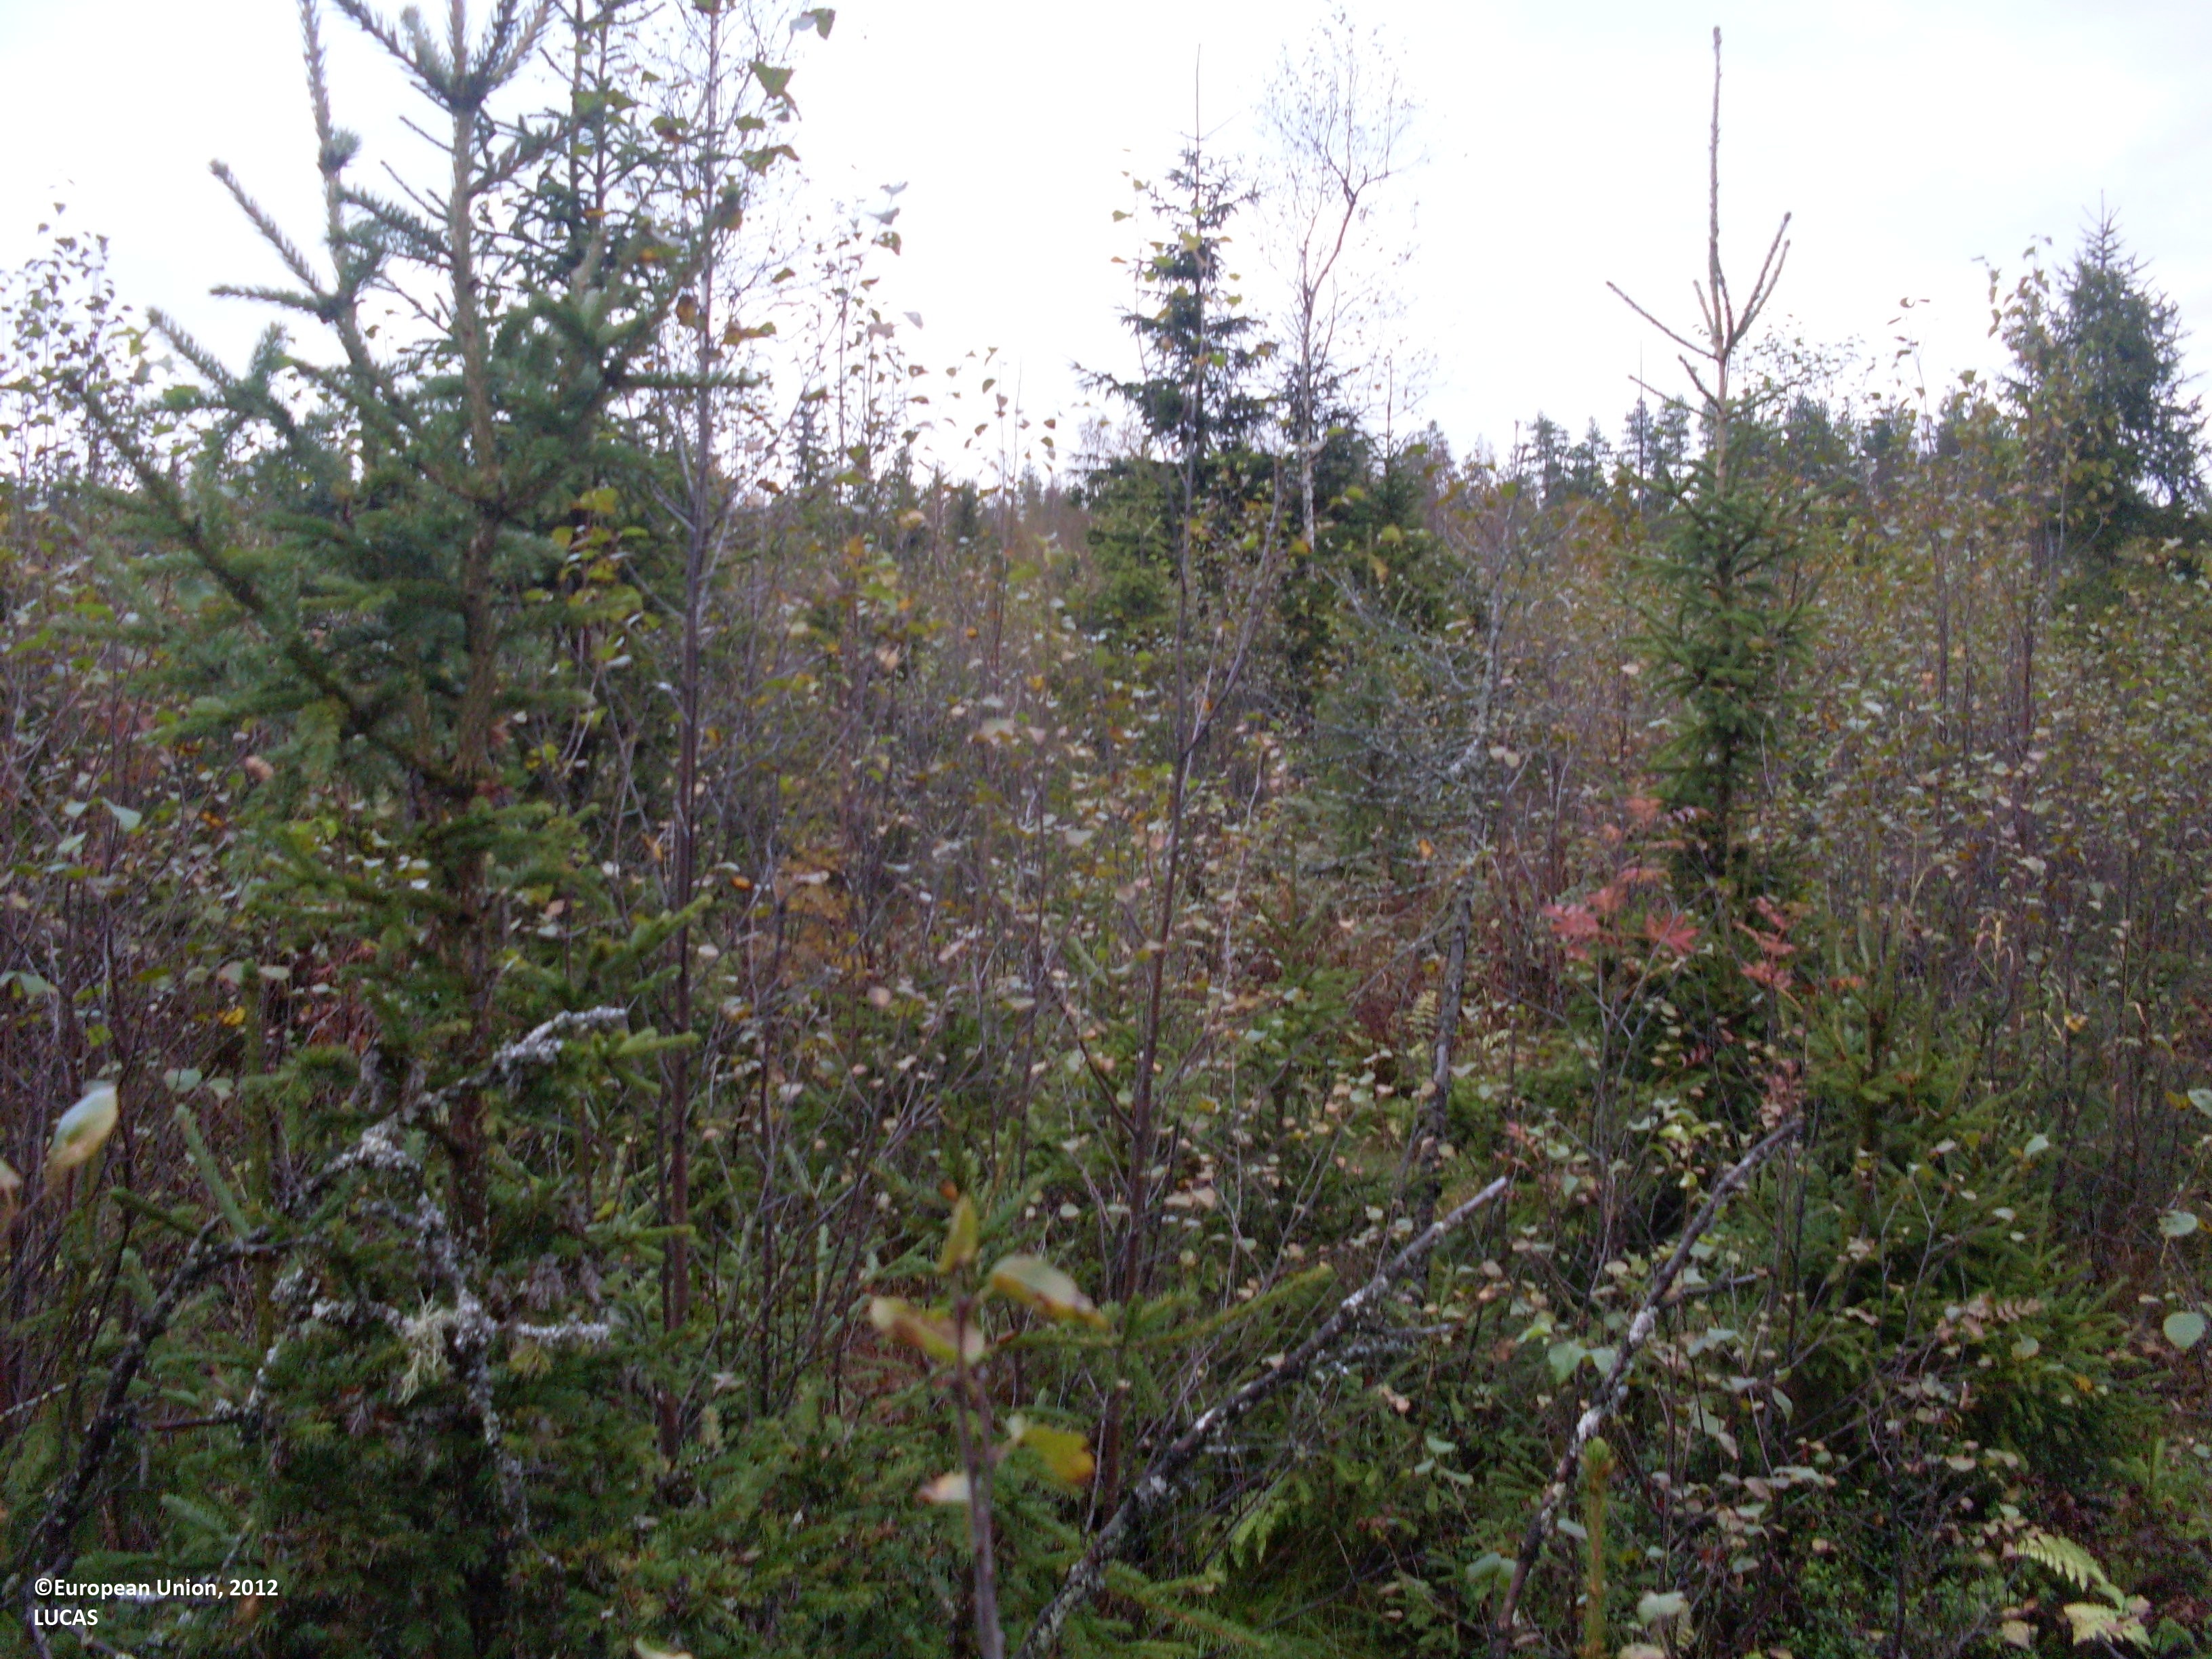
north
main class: Shrubland
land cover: Shrubland with sparse tree cover
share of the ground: > 75 %
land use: Forestry
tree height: < 5 m
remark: Clear cut
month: September
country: FI
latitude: 64.1753
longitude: 28.4704
